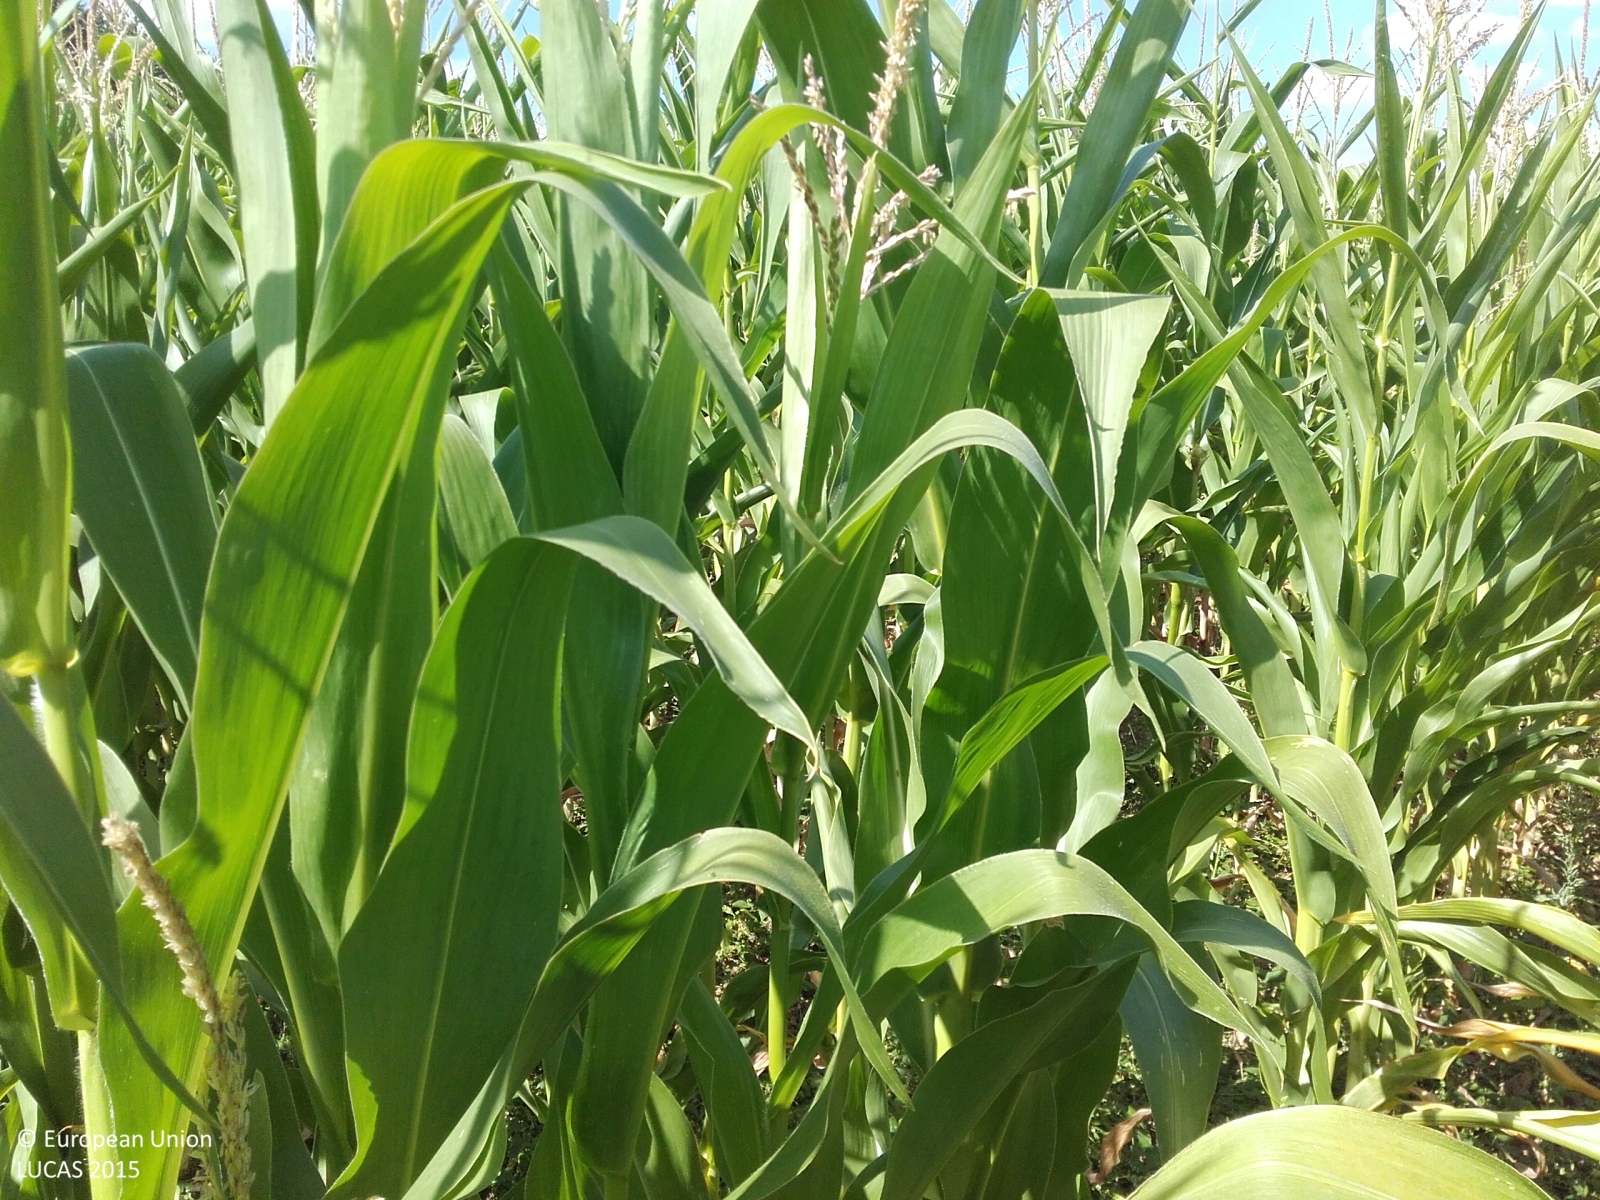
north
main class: Cropland
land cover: Maize
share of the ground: > 75 %
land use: Agriculture (excluding fallow land and kitchen gardens)
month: July
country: CZ
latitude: 49.9026
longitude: 16.2858
